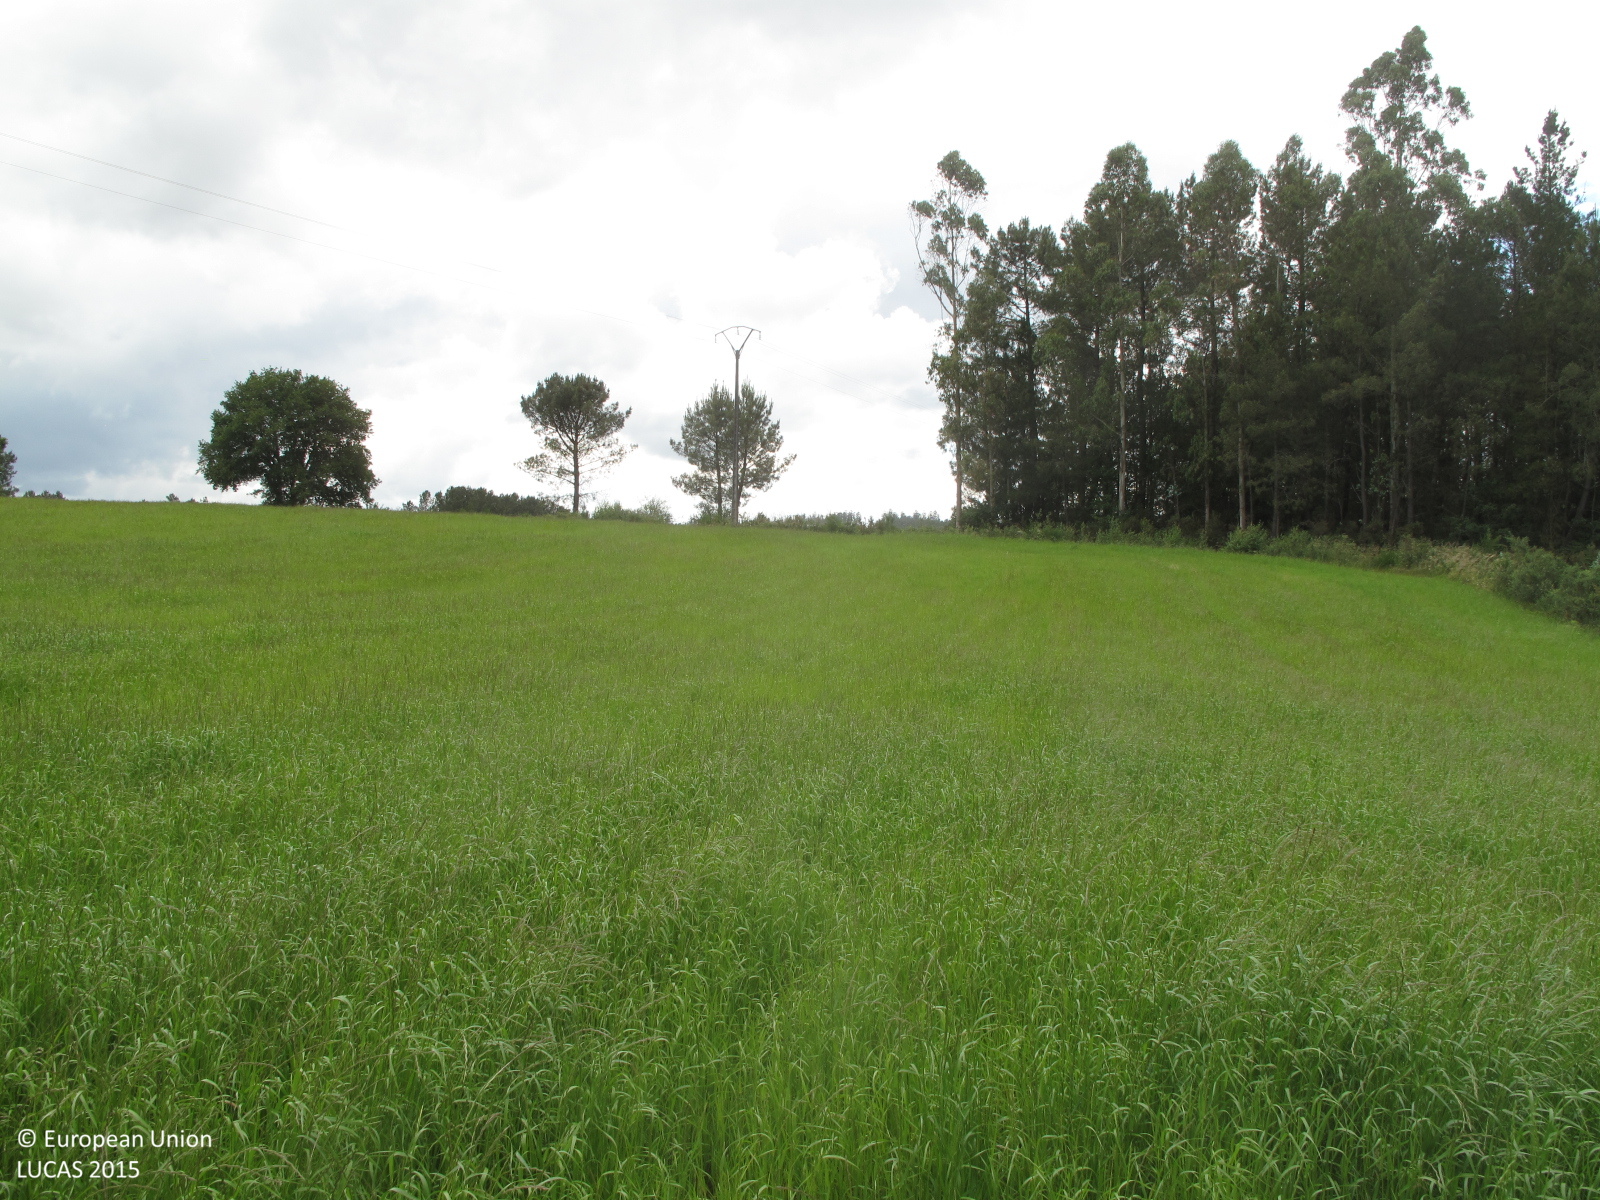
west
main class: Grassland
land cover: Grassland without tree/shrub cover
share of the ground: > 75 %
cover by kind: herbaceous plants 100 %
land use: Agriculture (excluding fallow land and kitchen gardens)
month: June
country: ES
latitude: 43.0202
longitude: -8.4991
